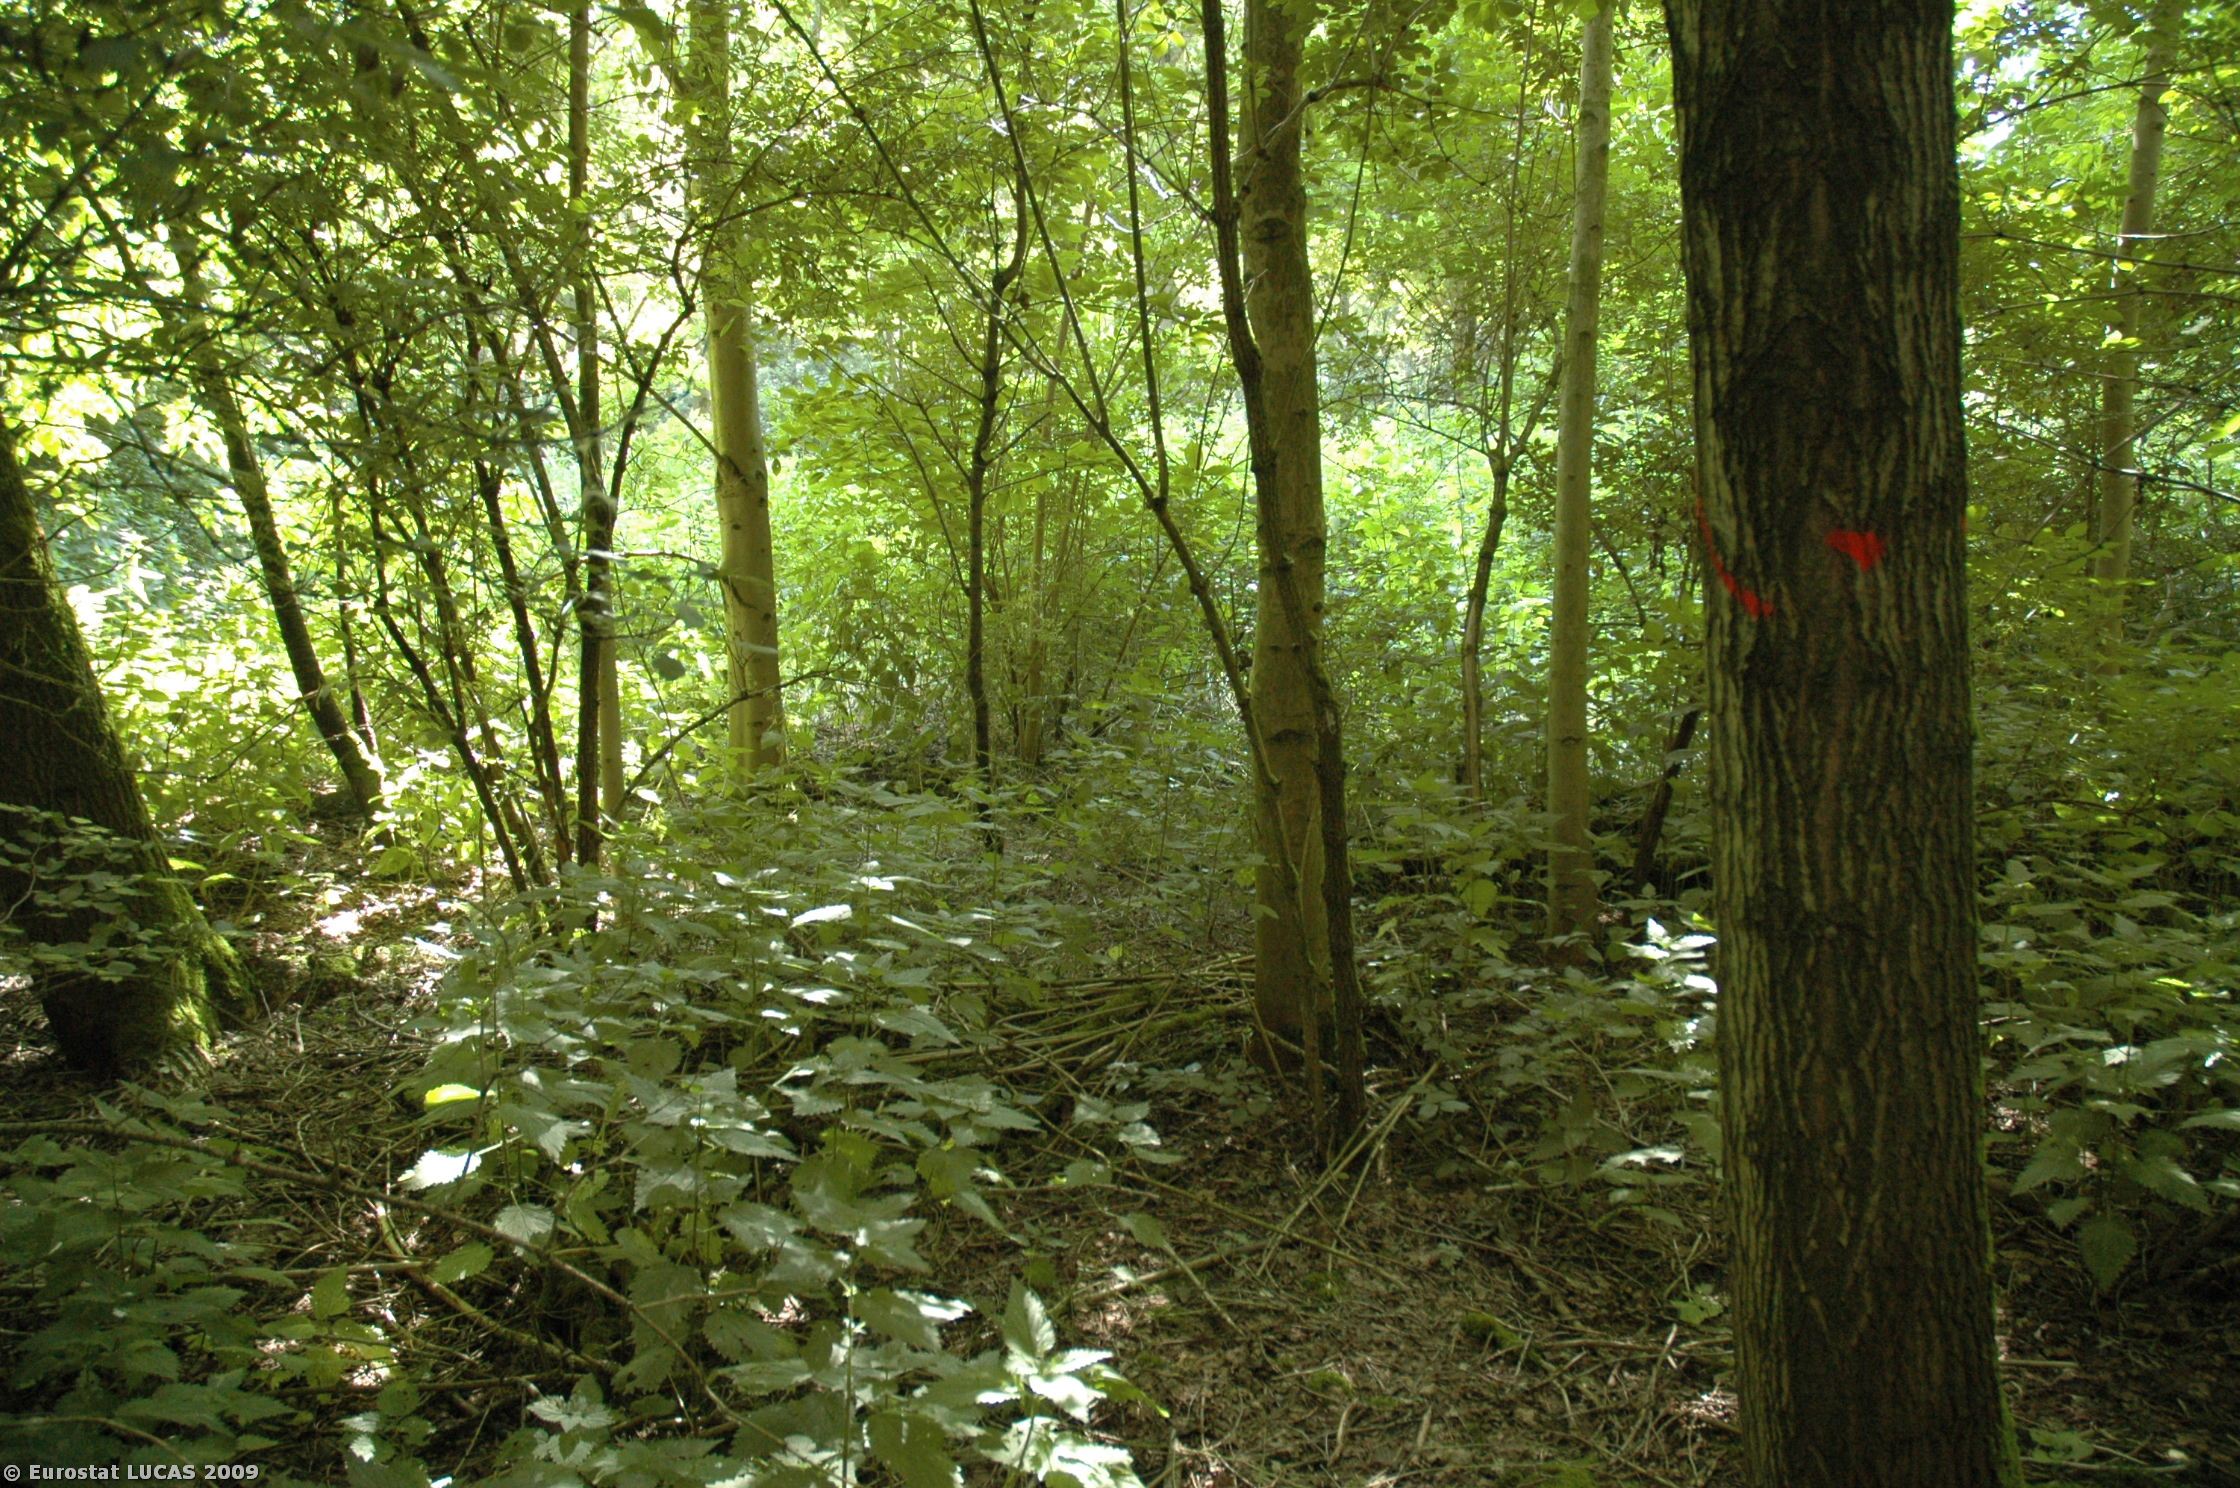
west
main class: Woodland
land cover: Broadleaved woodland
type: plantations and self-sown exotic forest
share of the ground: > 75 %
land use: Nature reserves
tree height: > 5 m
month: June
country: NL
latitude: 52.3738
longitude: 5.2829
